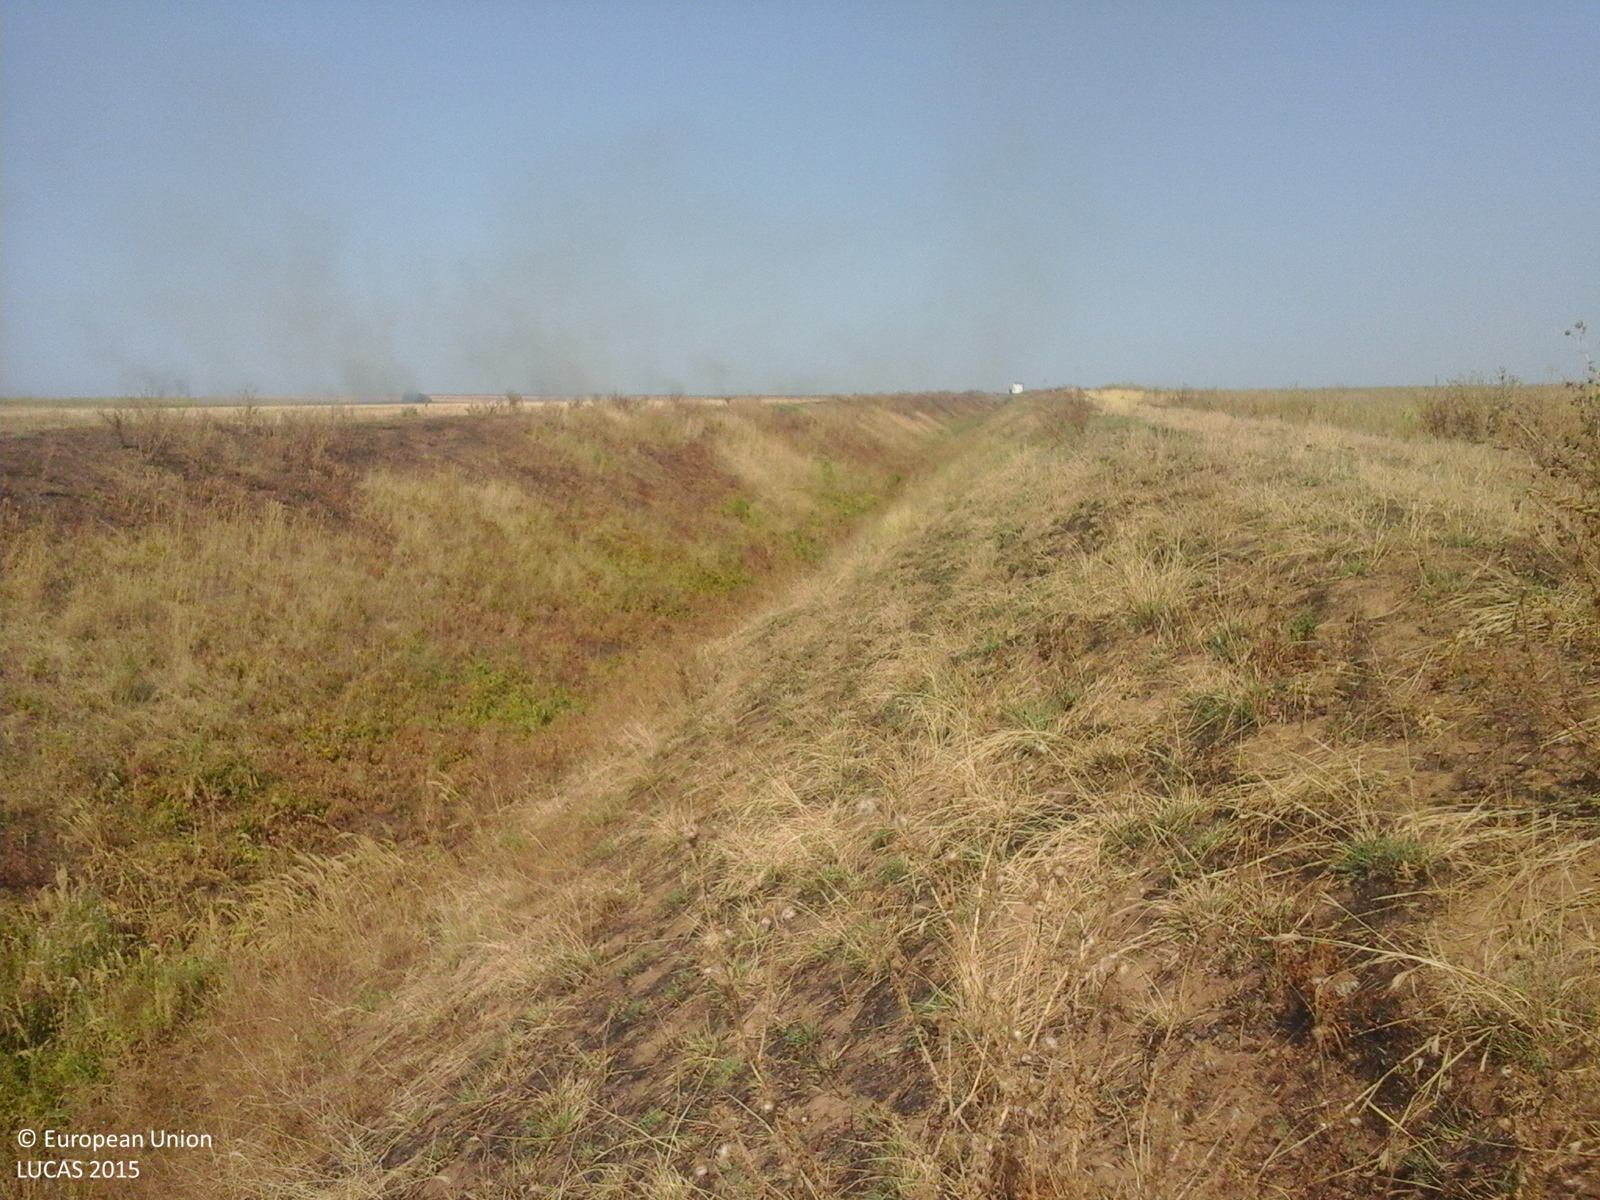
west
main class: Grassland
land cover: Spontaneously vegetated surfaces
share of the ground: > 75 %
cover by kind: herbaceous plants 100 %
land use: Fallow land
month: August
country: RO
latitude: 44.2548
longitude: 23.0320
